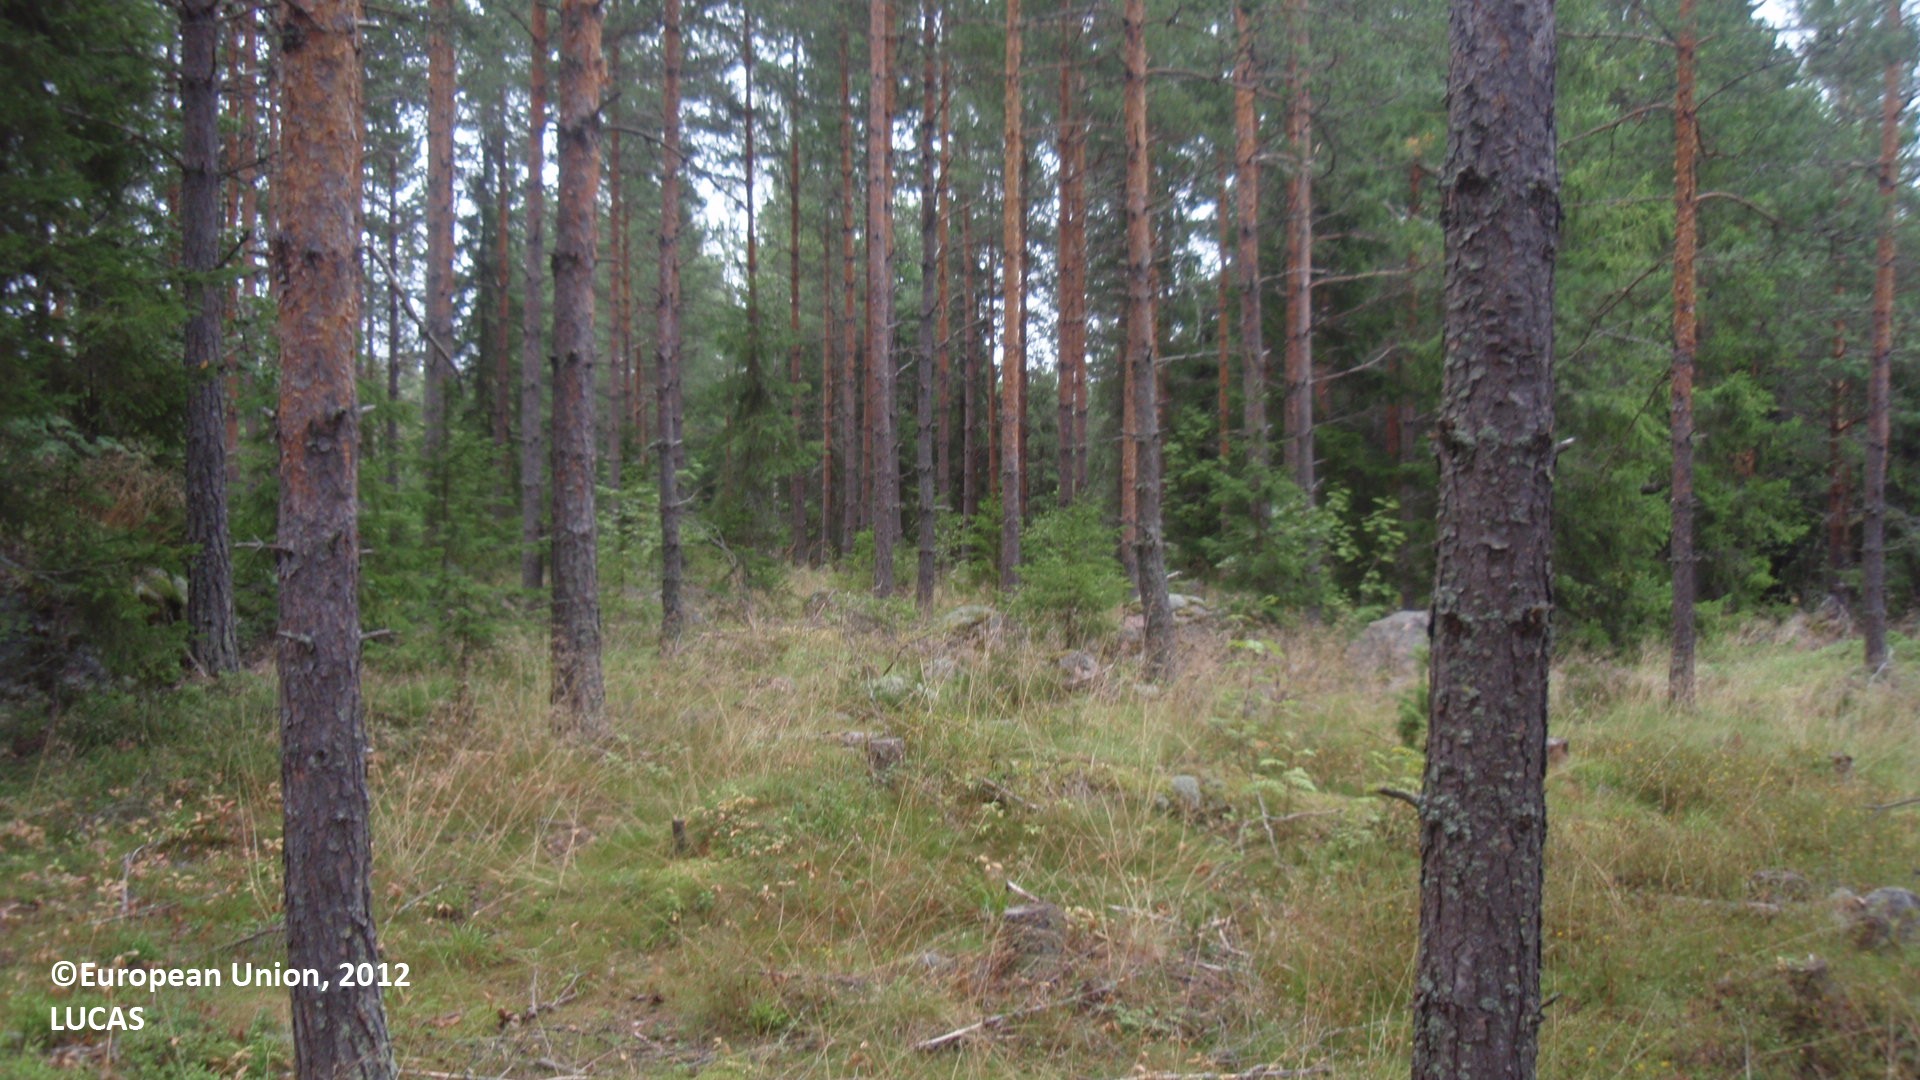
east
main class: Woodland
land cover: Other coniferous woodland
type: boreal forest
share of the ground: 50 - 75 %
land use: Forestry
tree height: > 5 m
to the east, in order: Other coniferous woodland; Tracks; Broadleaved woodland; Artificial constructions in urban areas; Shrubland with sparse tree cover; Grass margins; Paved roads, cycling and walking lanes; Grass margins; Rye; Shrubland with sparse tree cover; Ditches and canals; Spruce dominated coniferous woodland
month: August
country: FI
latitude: 60.5809
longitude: 26.8281
